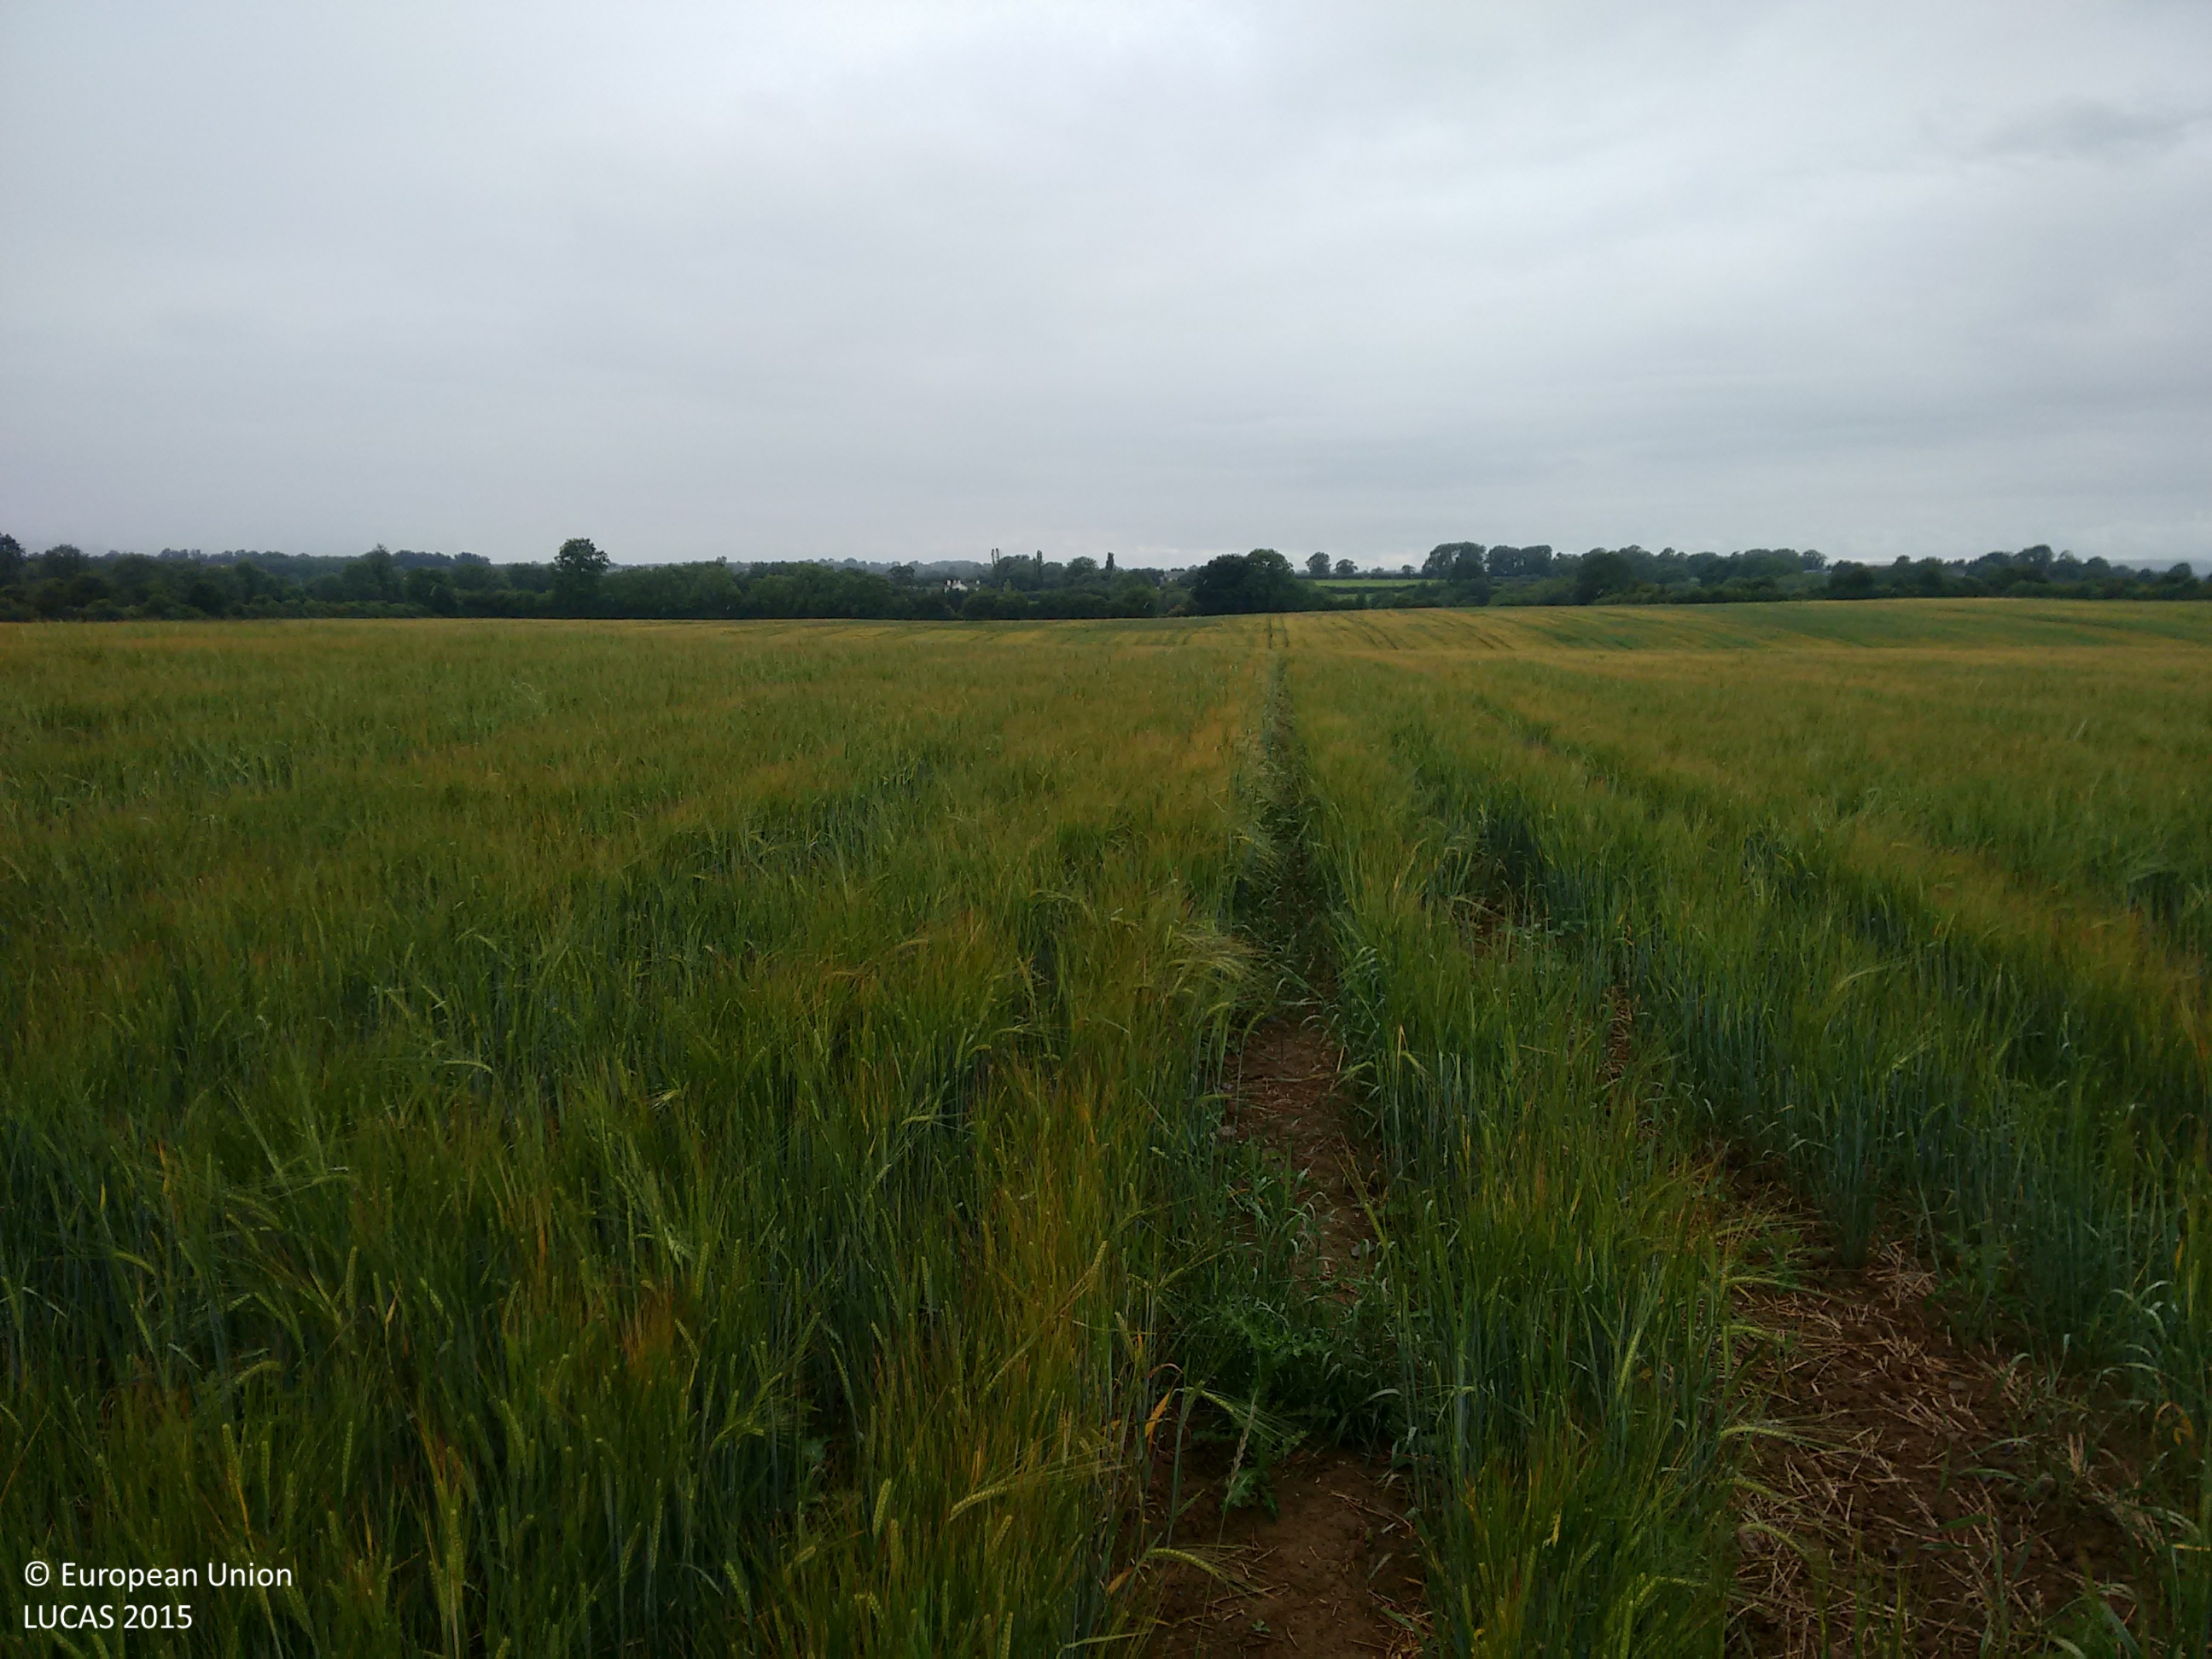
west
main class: Cropland
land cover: Barley
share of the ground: > 75 %
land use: Agriculture (excluding fallow land and kitchen gardens)
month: July
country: IE
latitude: 52.5599
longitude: -7.2165
